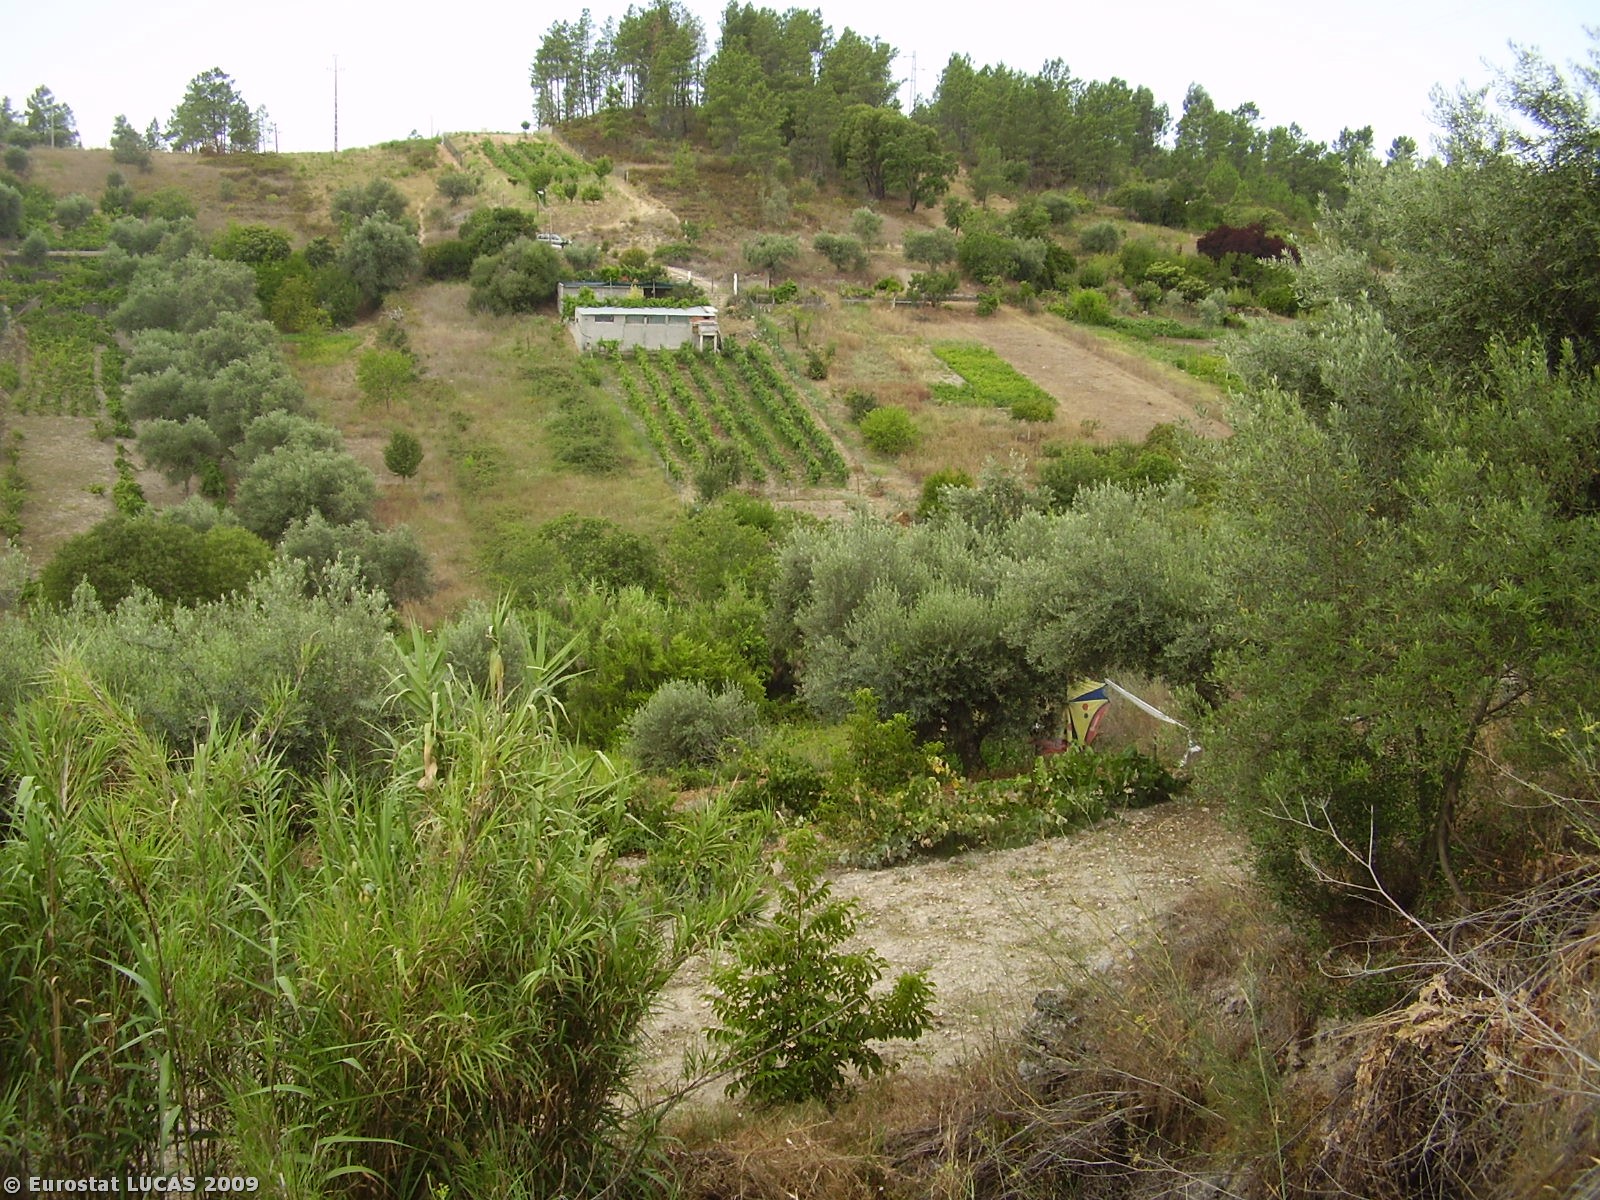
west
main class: Cropland
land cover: Olive groves
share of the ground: 10 - 25 %
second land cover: Shrubland with sparse tree cover
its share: > 75 %
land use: Agriculture (excluding fallow land and kitchen gardens)
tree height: > 5 m
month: July
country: PT
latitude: 39.4882
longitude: -8.0233
